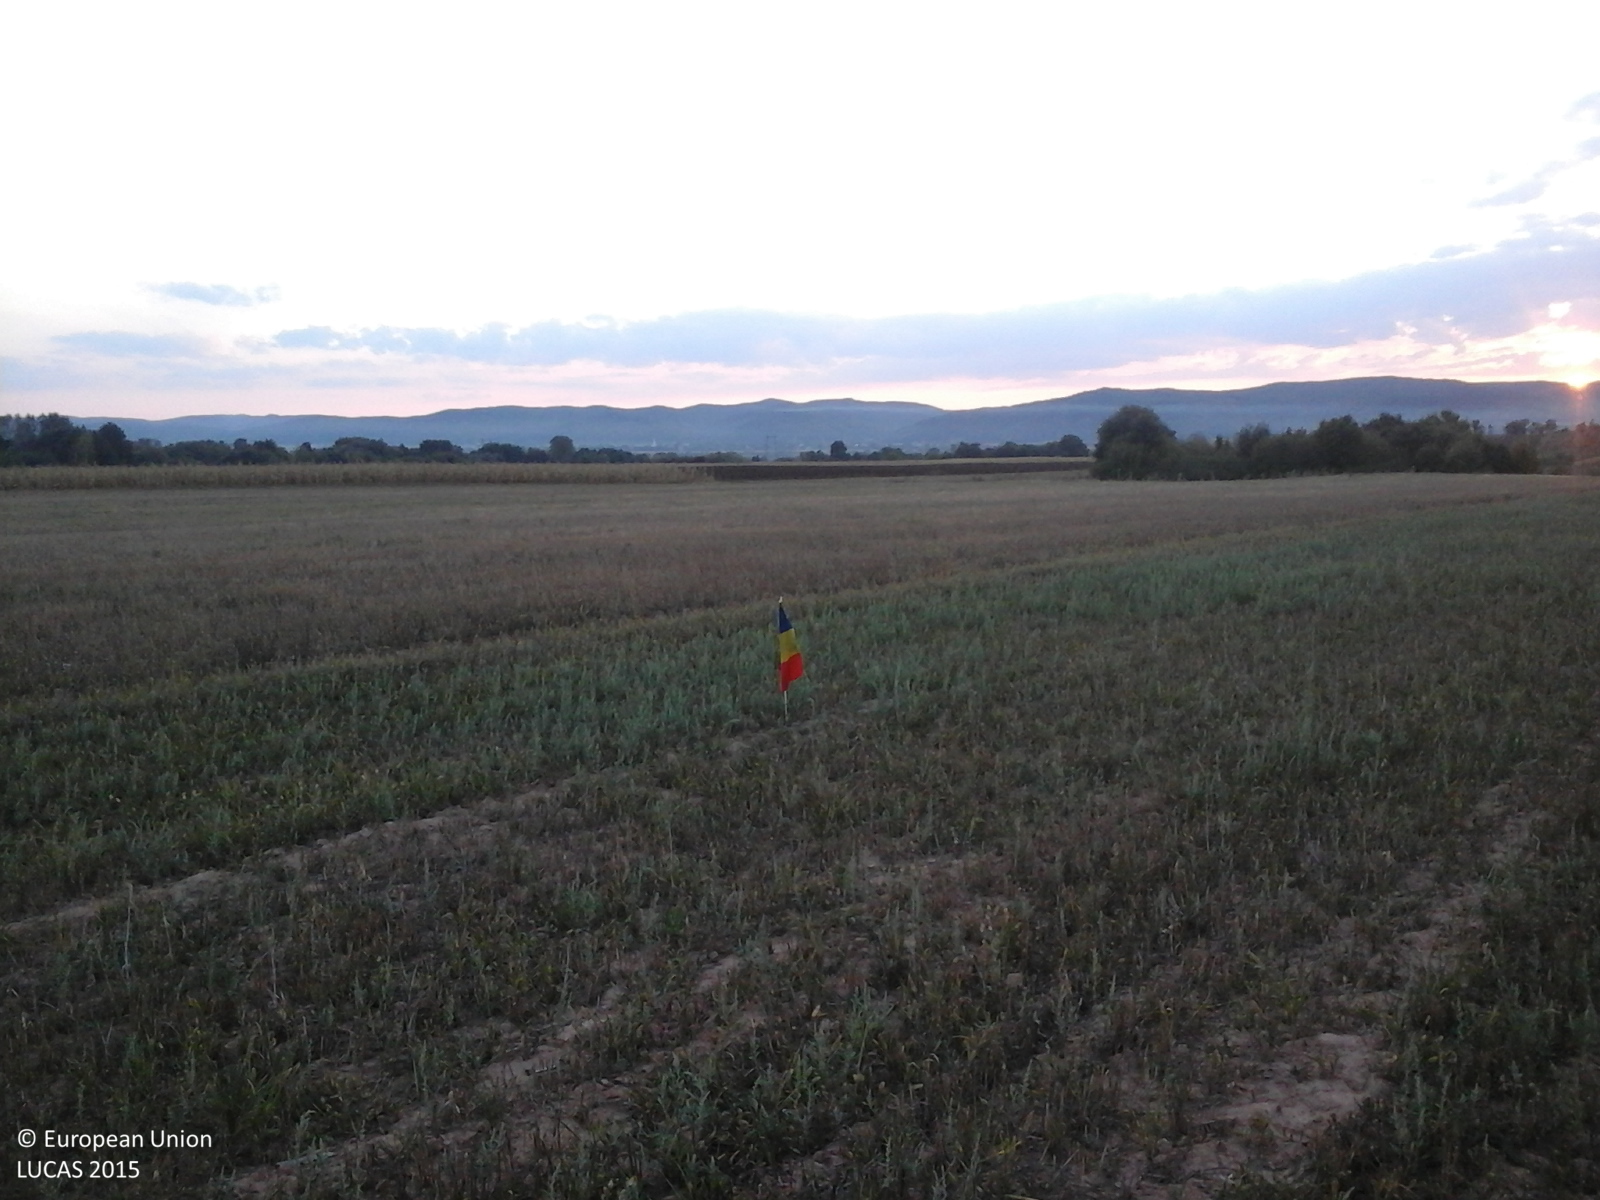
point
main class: Cropland
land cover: Oats
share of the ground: > 75 %
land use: Agriculture (excluding fallow land and kitchen gardens)
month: September
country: RO
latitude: 47.3382
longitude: 23.3175
